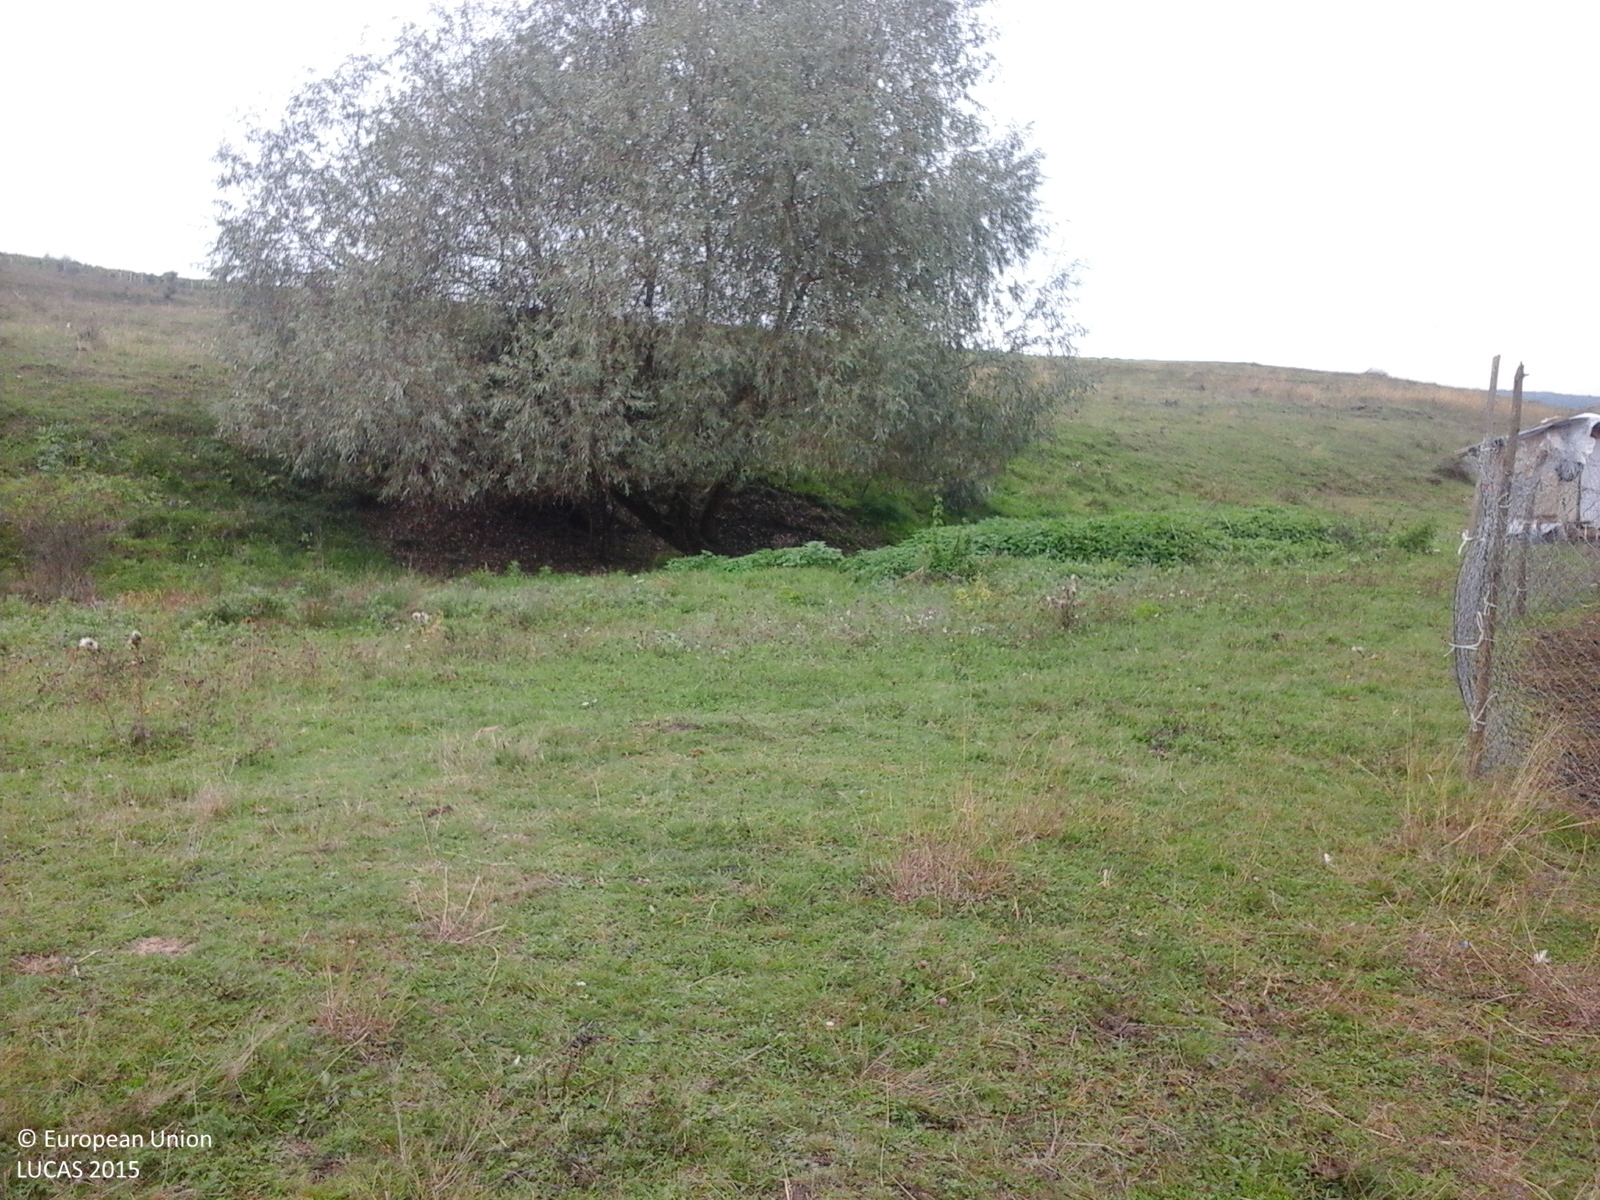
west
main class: Grassland
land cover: Grassland without tree/shrub cover
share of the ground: > 75 %
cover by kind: herbaceous plants 100 %
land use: Agriculture (excluding fallow land and kitchen gardens)
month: October
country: RO
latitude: 46.1958
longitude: 24.1107
